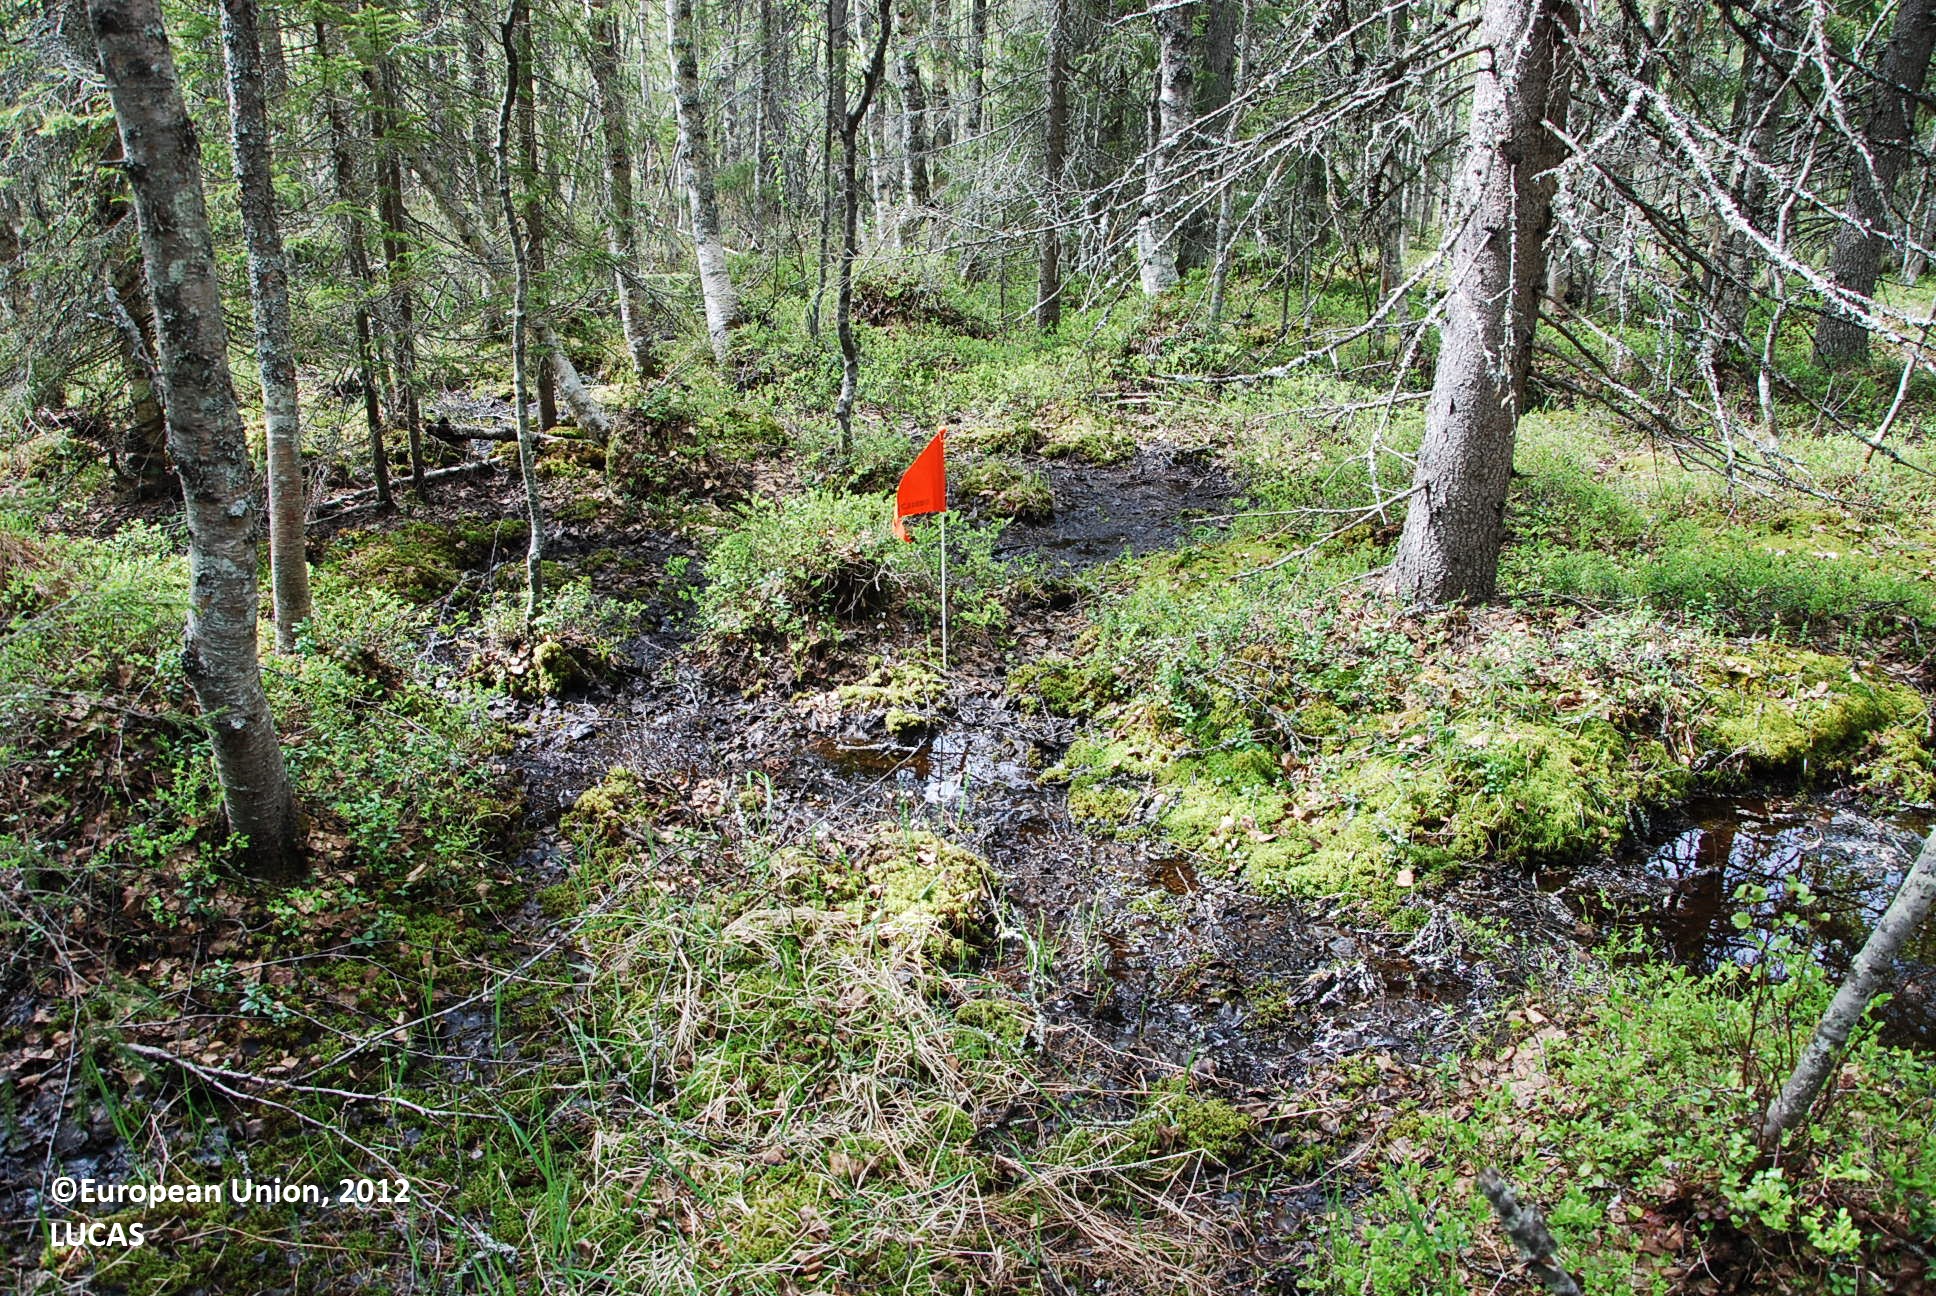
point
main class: Woodland
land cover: Spruce dominated mixed woodland
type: boreal forest
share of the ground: > 75 %
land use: Forestry
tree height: > 5 m
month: June
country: FI
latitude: 66.2062
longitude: 27.6949
